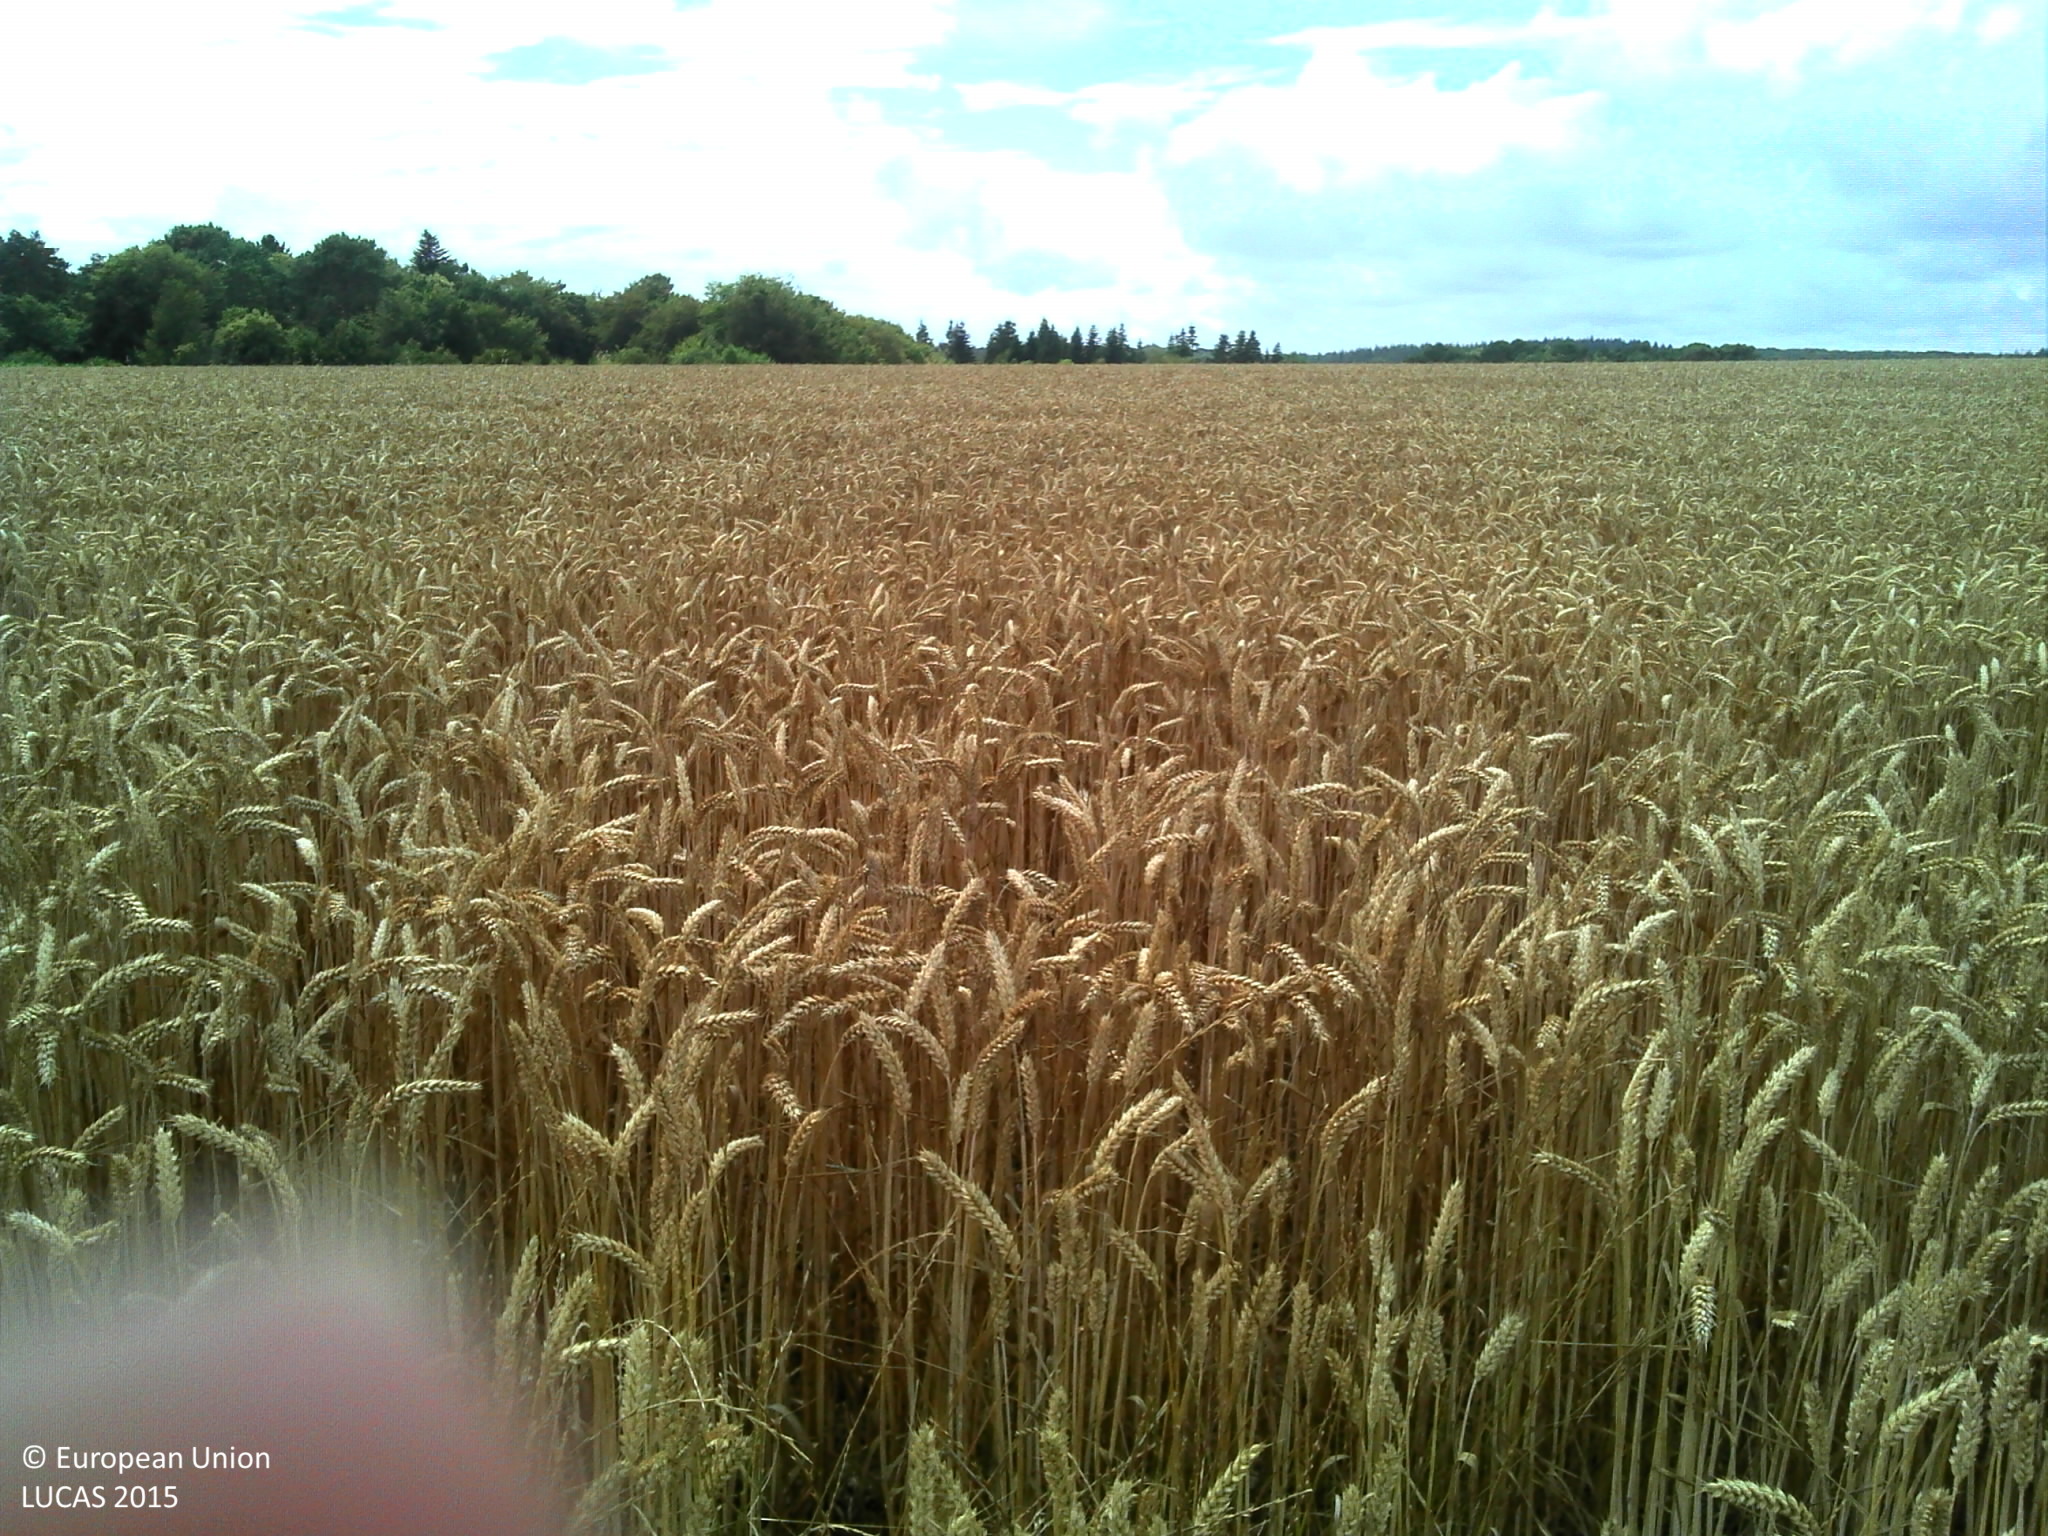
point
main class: Cropland
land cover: Common wheat
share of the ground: > 75 %
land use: Agriculture (excluding fallow land and kitchen gardens)
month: July
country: FR
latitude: 47.8229
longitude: -3.5267
